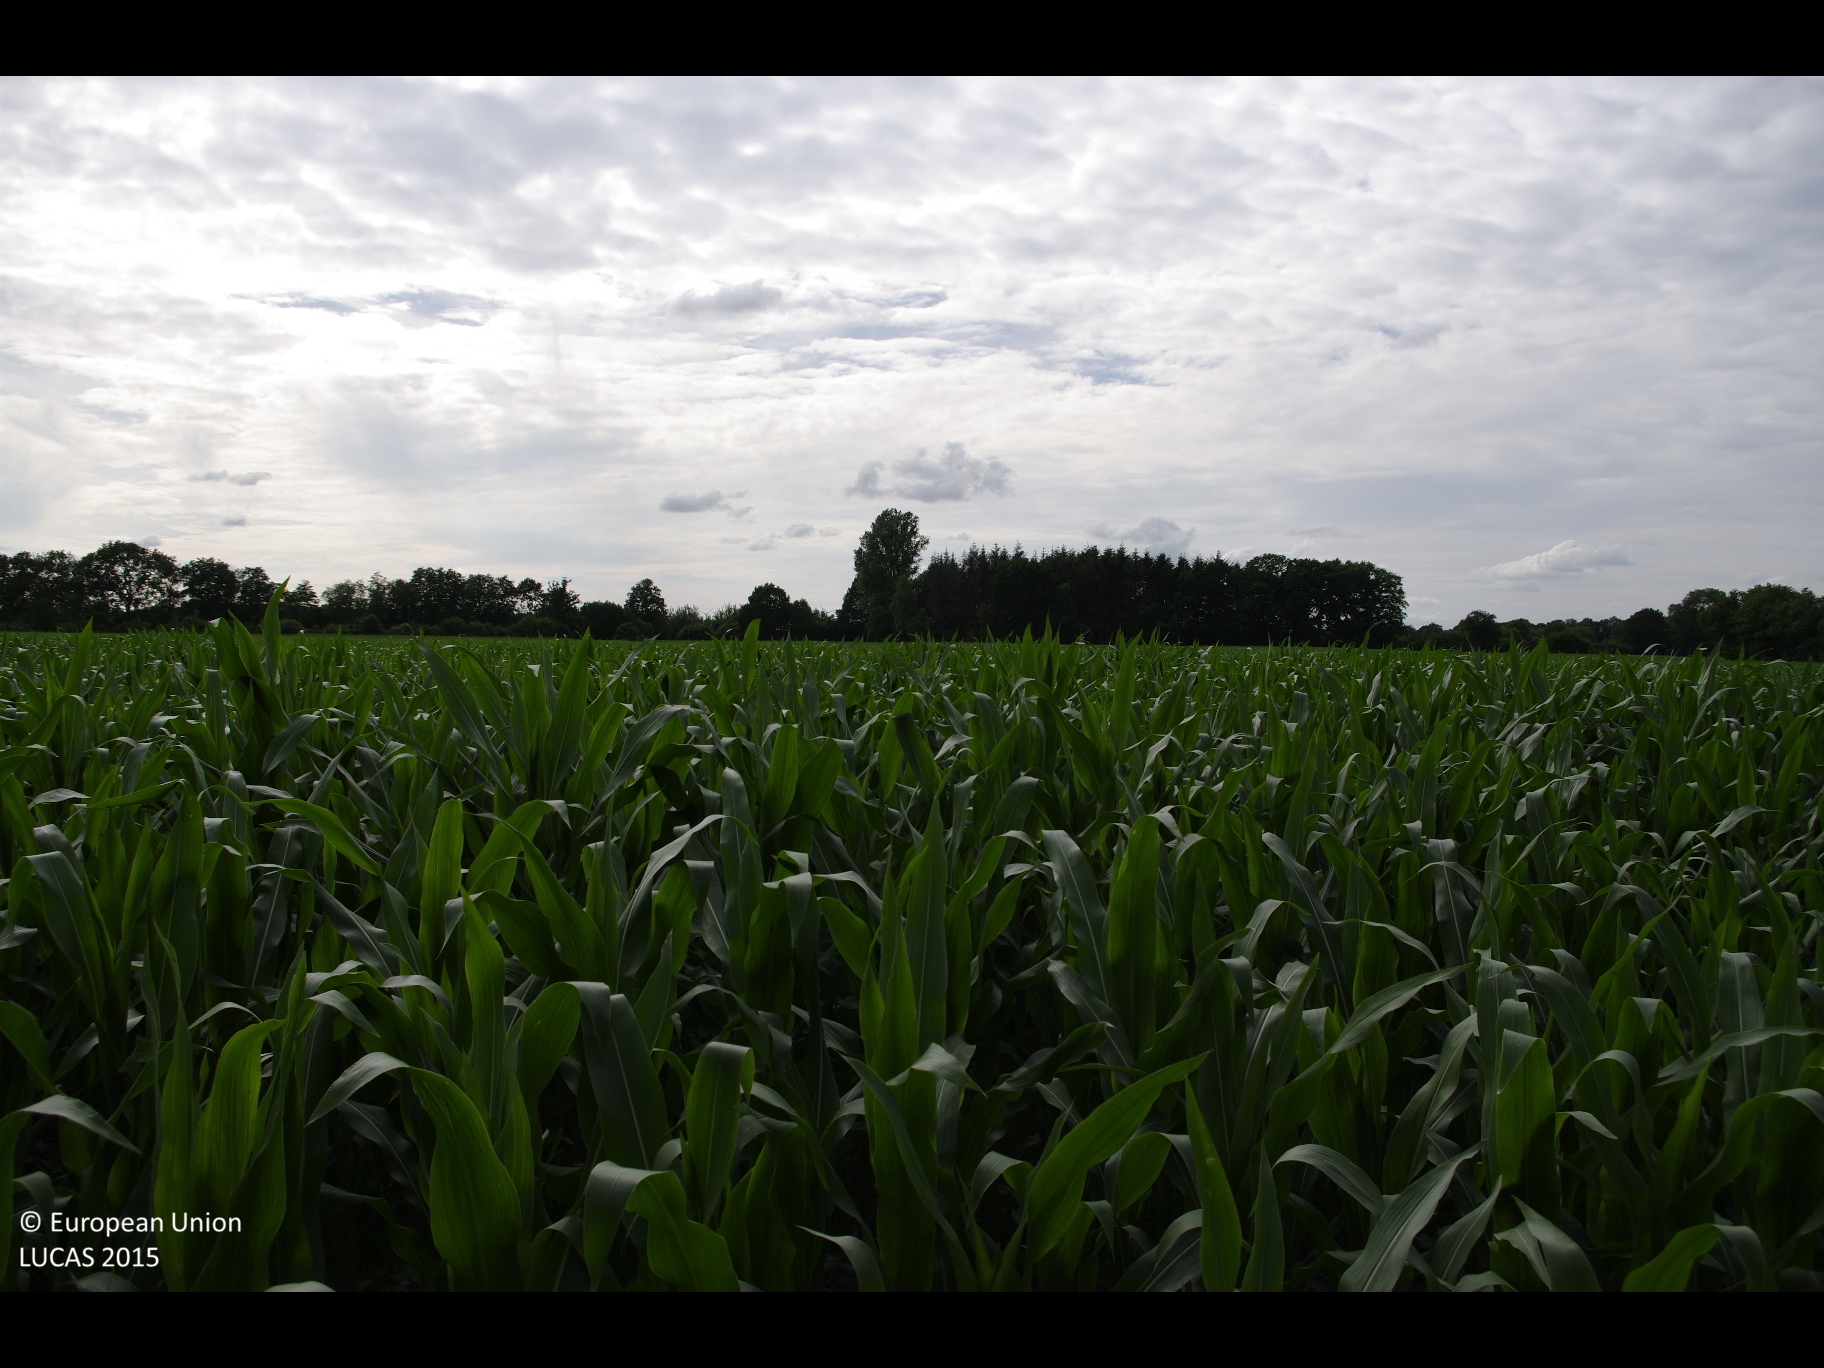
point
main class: Cropland
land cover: Maize
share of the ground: > 75 %
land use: Agriculture (excluding fallow land and kitchen gardens)
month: July
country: DE
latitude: 53.9950
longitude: 9.9543
